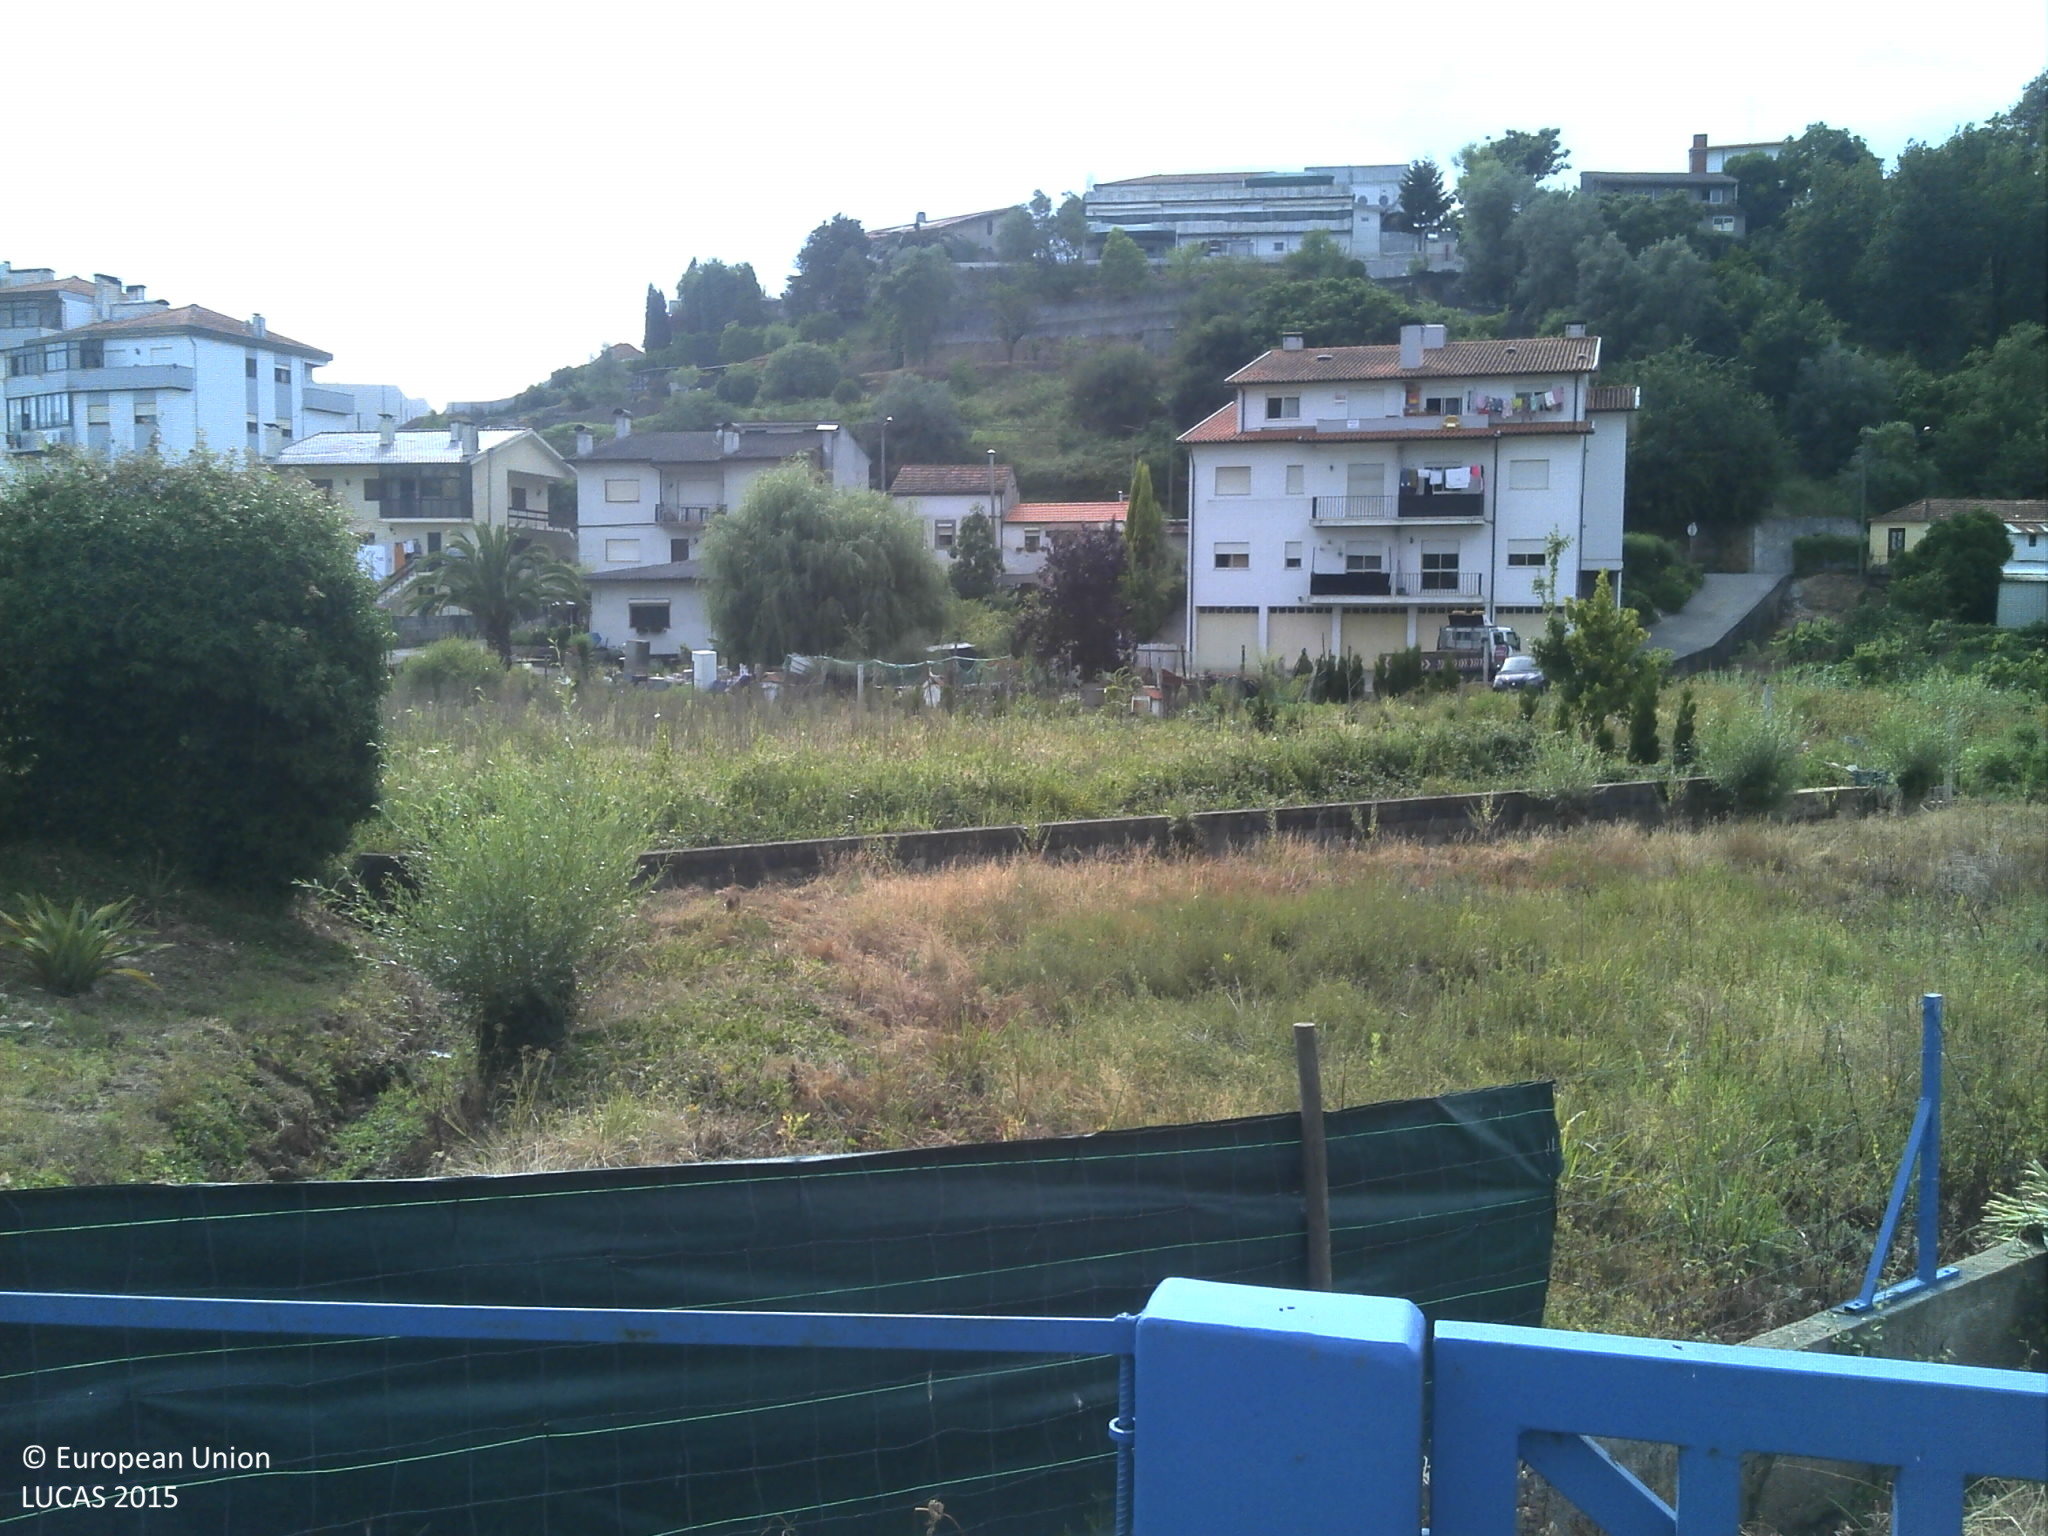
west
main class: Grassland
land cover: Spontaneously vegetated surfaces
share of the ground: > 75 %
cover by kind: herbaceous plants 80 %, unconsolidated bare surface 20 %
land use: Fallow land
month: June
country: PT
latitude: 40.5746
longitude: -8.4355
